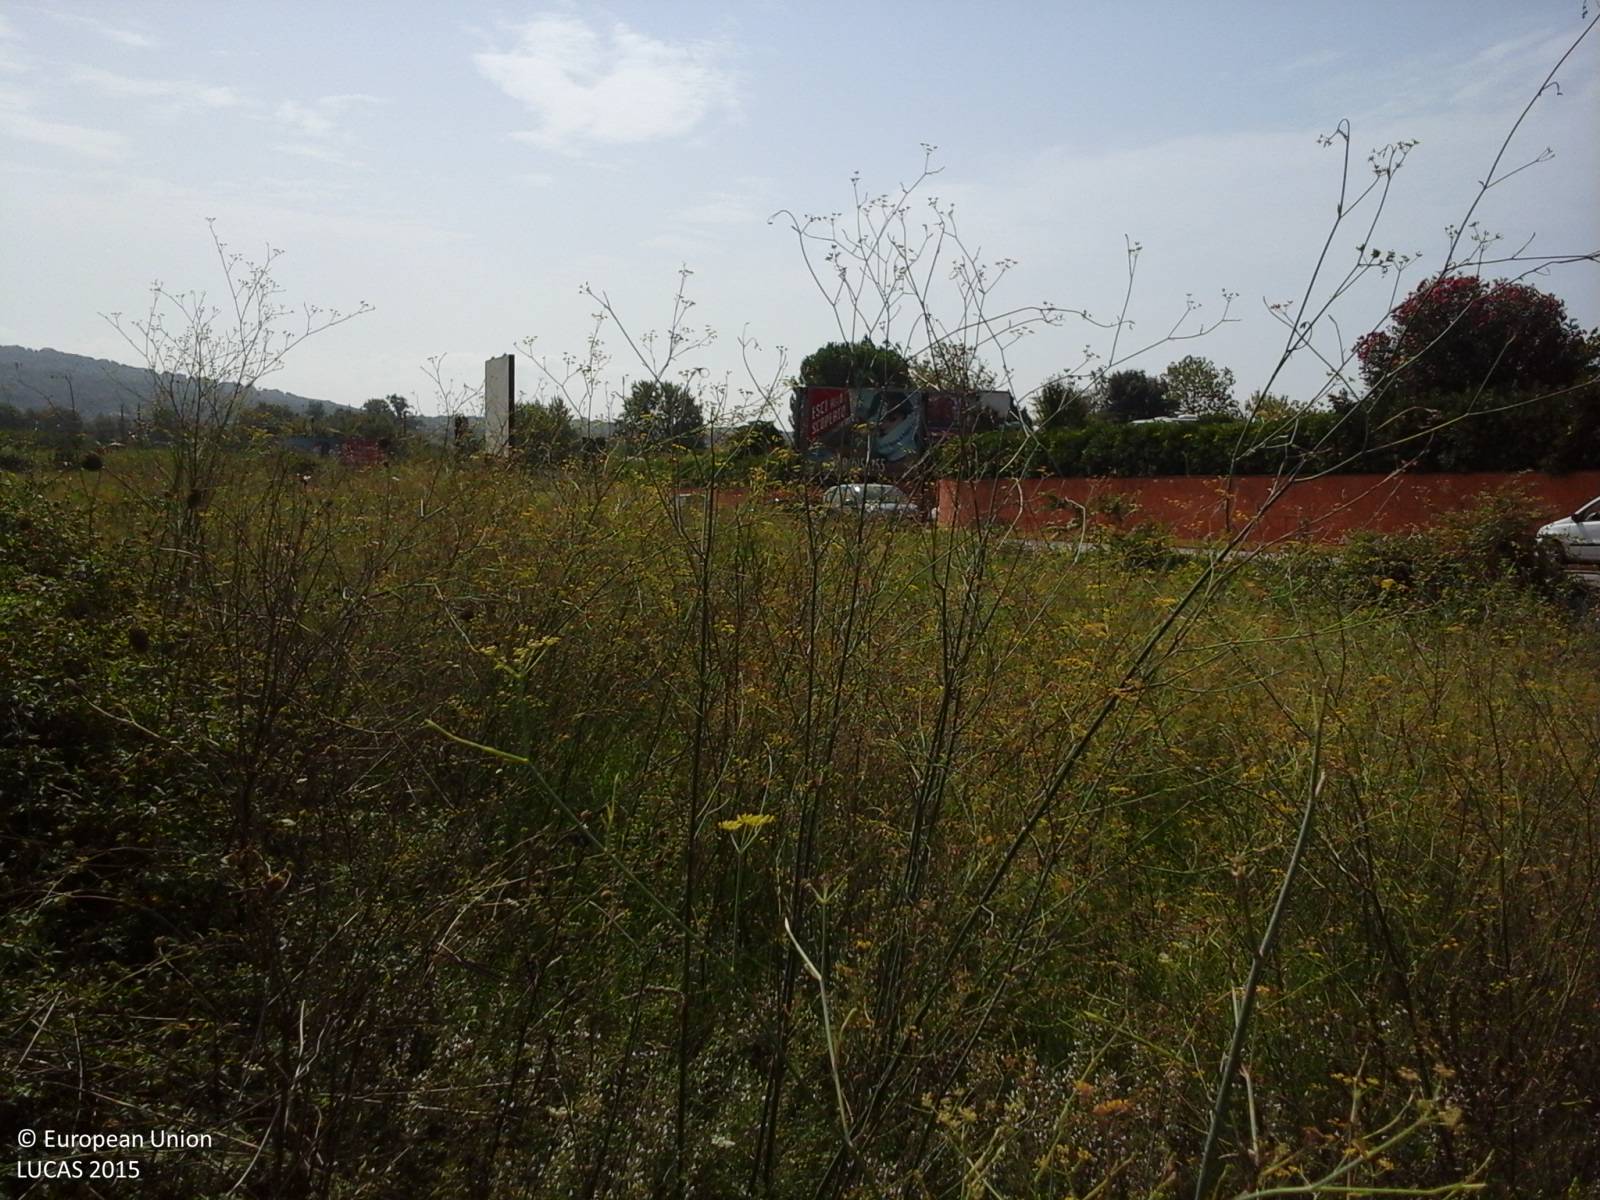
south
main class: Grassland
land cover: Grassland without tree/shrub cover
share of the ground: > 75 %
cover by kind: herbaceous plants 100 %
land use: Abandoned areas
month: September
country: IT
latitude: 41.2670
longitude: 13.6738
